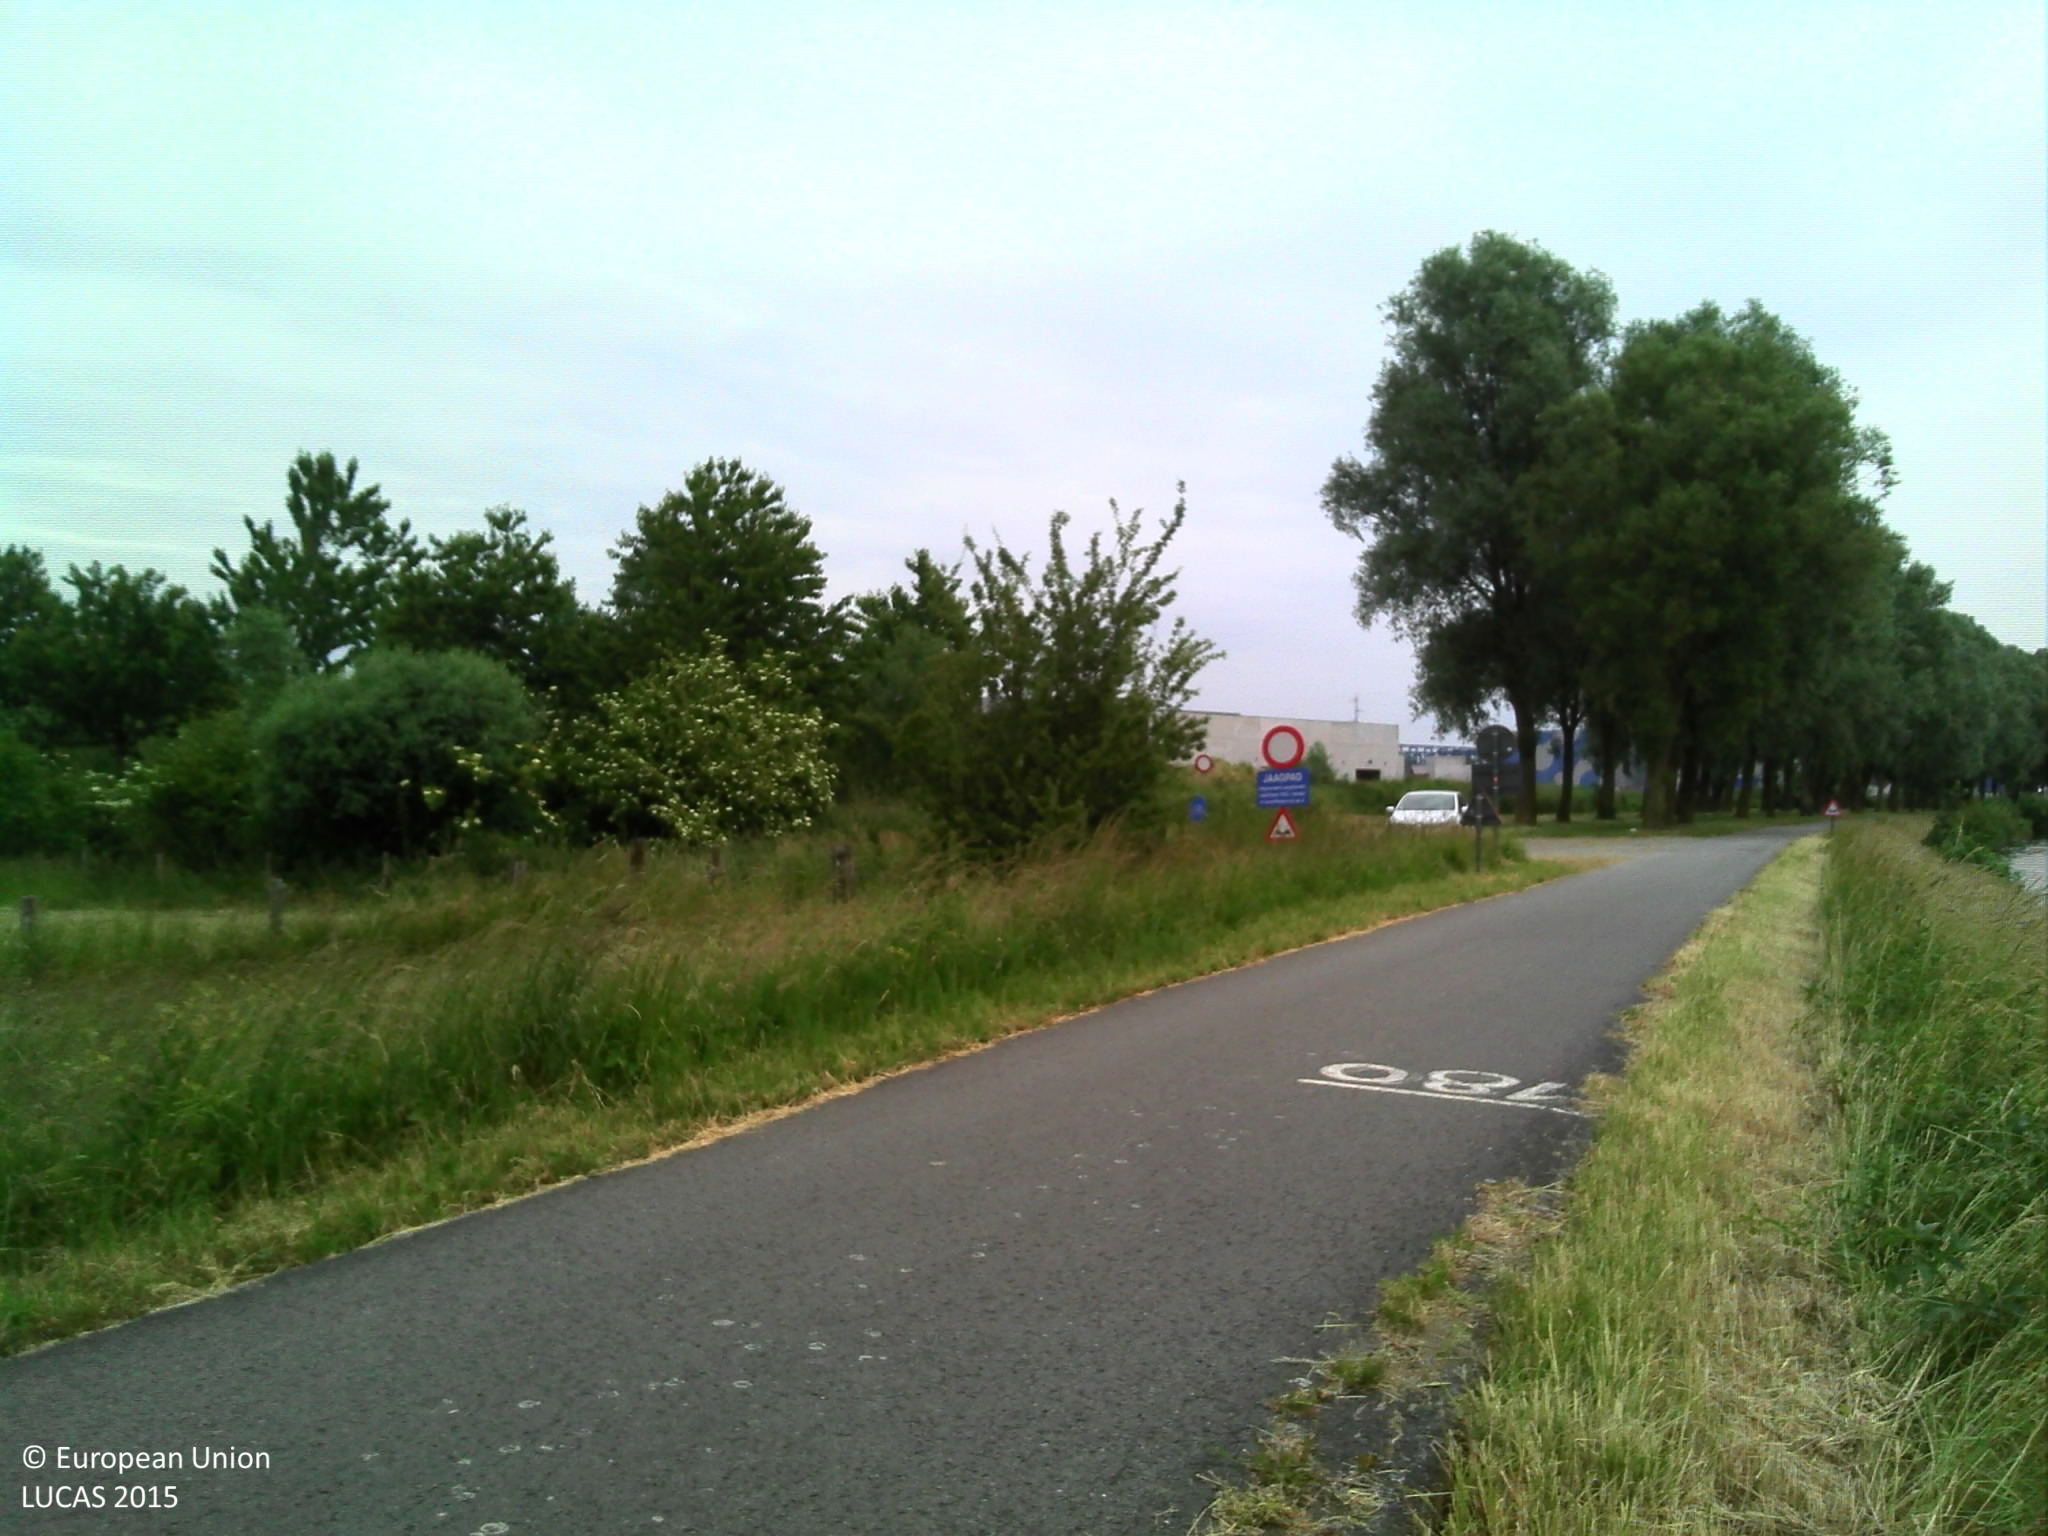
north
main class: Grassland
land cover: Spontaneously vegetated surfaces
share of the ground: > 75 %
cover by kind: herbaceous plants 100 %
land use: Semi-natural and natural areas not in use
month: June
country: BE
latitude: 50.8336
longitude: 3.5889
